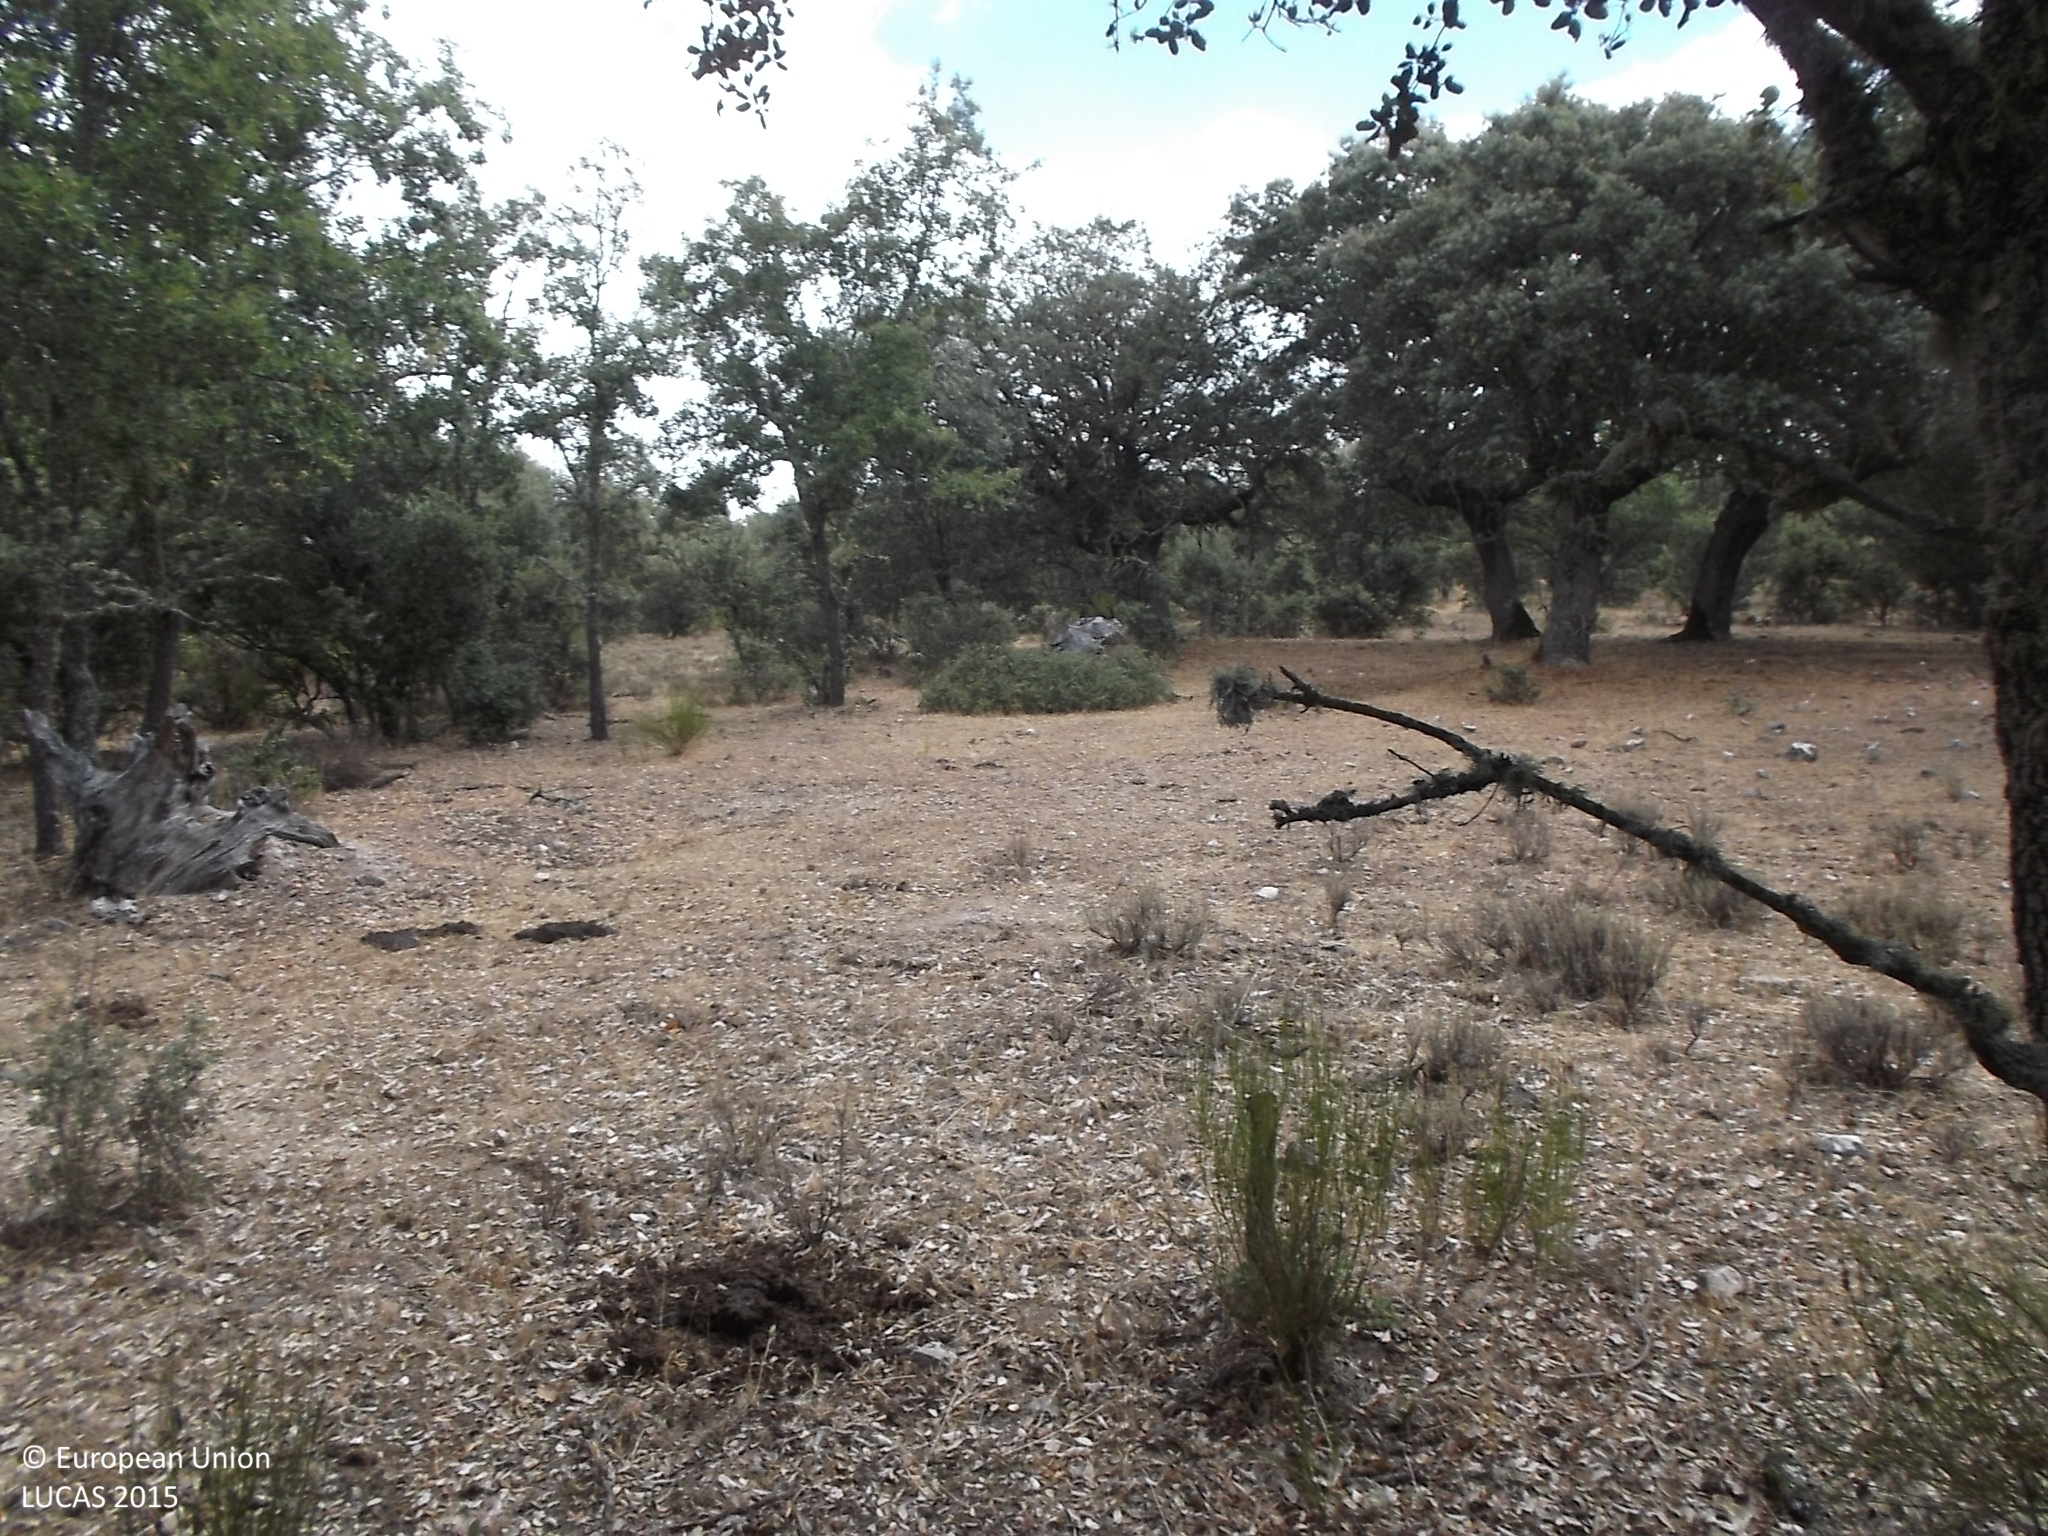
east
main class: Woodland
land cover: Broadleaved woodland
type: broadleaved evergreen forest
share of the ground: 25 - 50 %
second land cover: Shrubland without tree cover
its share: 25 - 50 %
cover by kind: broadleaved forest trees 40 %, shrubs 40 %, herbaceous plants 20 %
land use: Forestry
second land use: Agriculture (excluding fallow land and kitchen gardens)
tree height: < 5 m
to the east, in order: Broadleaved woodland; Shrubland without tree cover
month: July
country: ES
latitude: 40.9034
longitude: -6.3905
